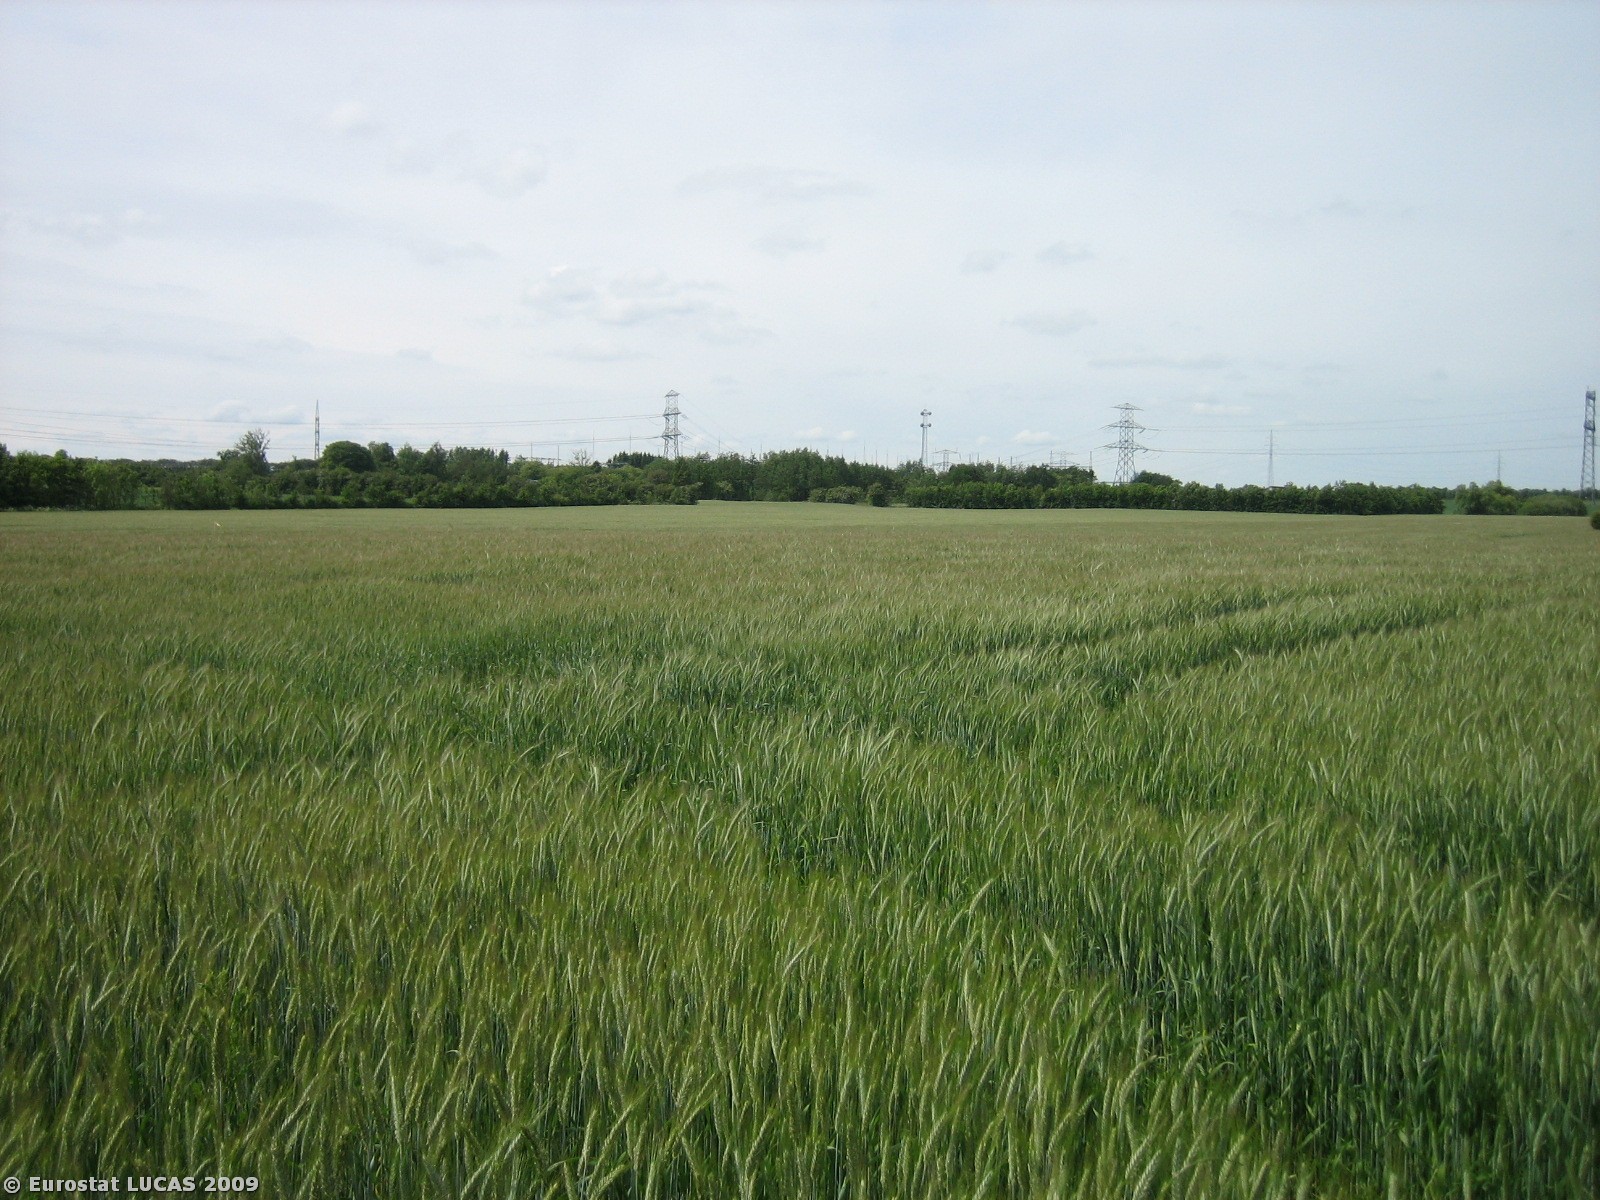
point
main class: Cropland
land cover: Rye
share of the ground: > 75 %
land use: Agriculture (excluding fallow land and kitchen gardens)
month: June
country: DK
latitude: 56.2775
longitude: 10.1452
